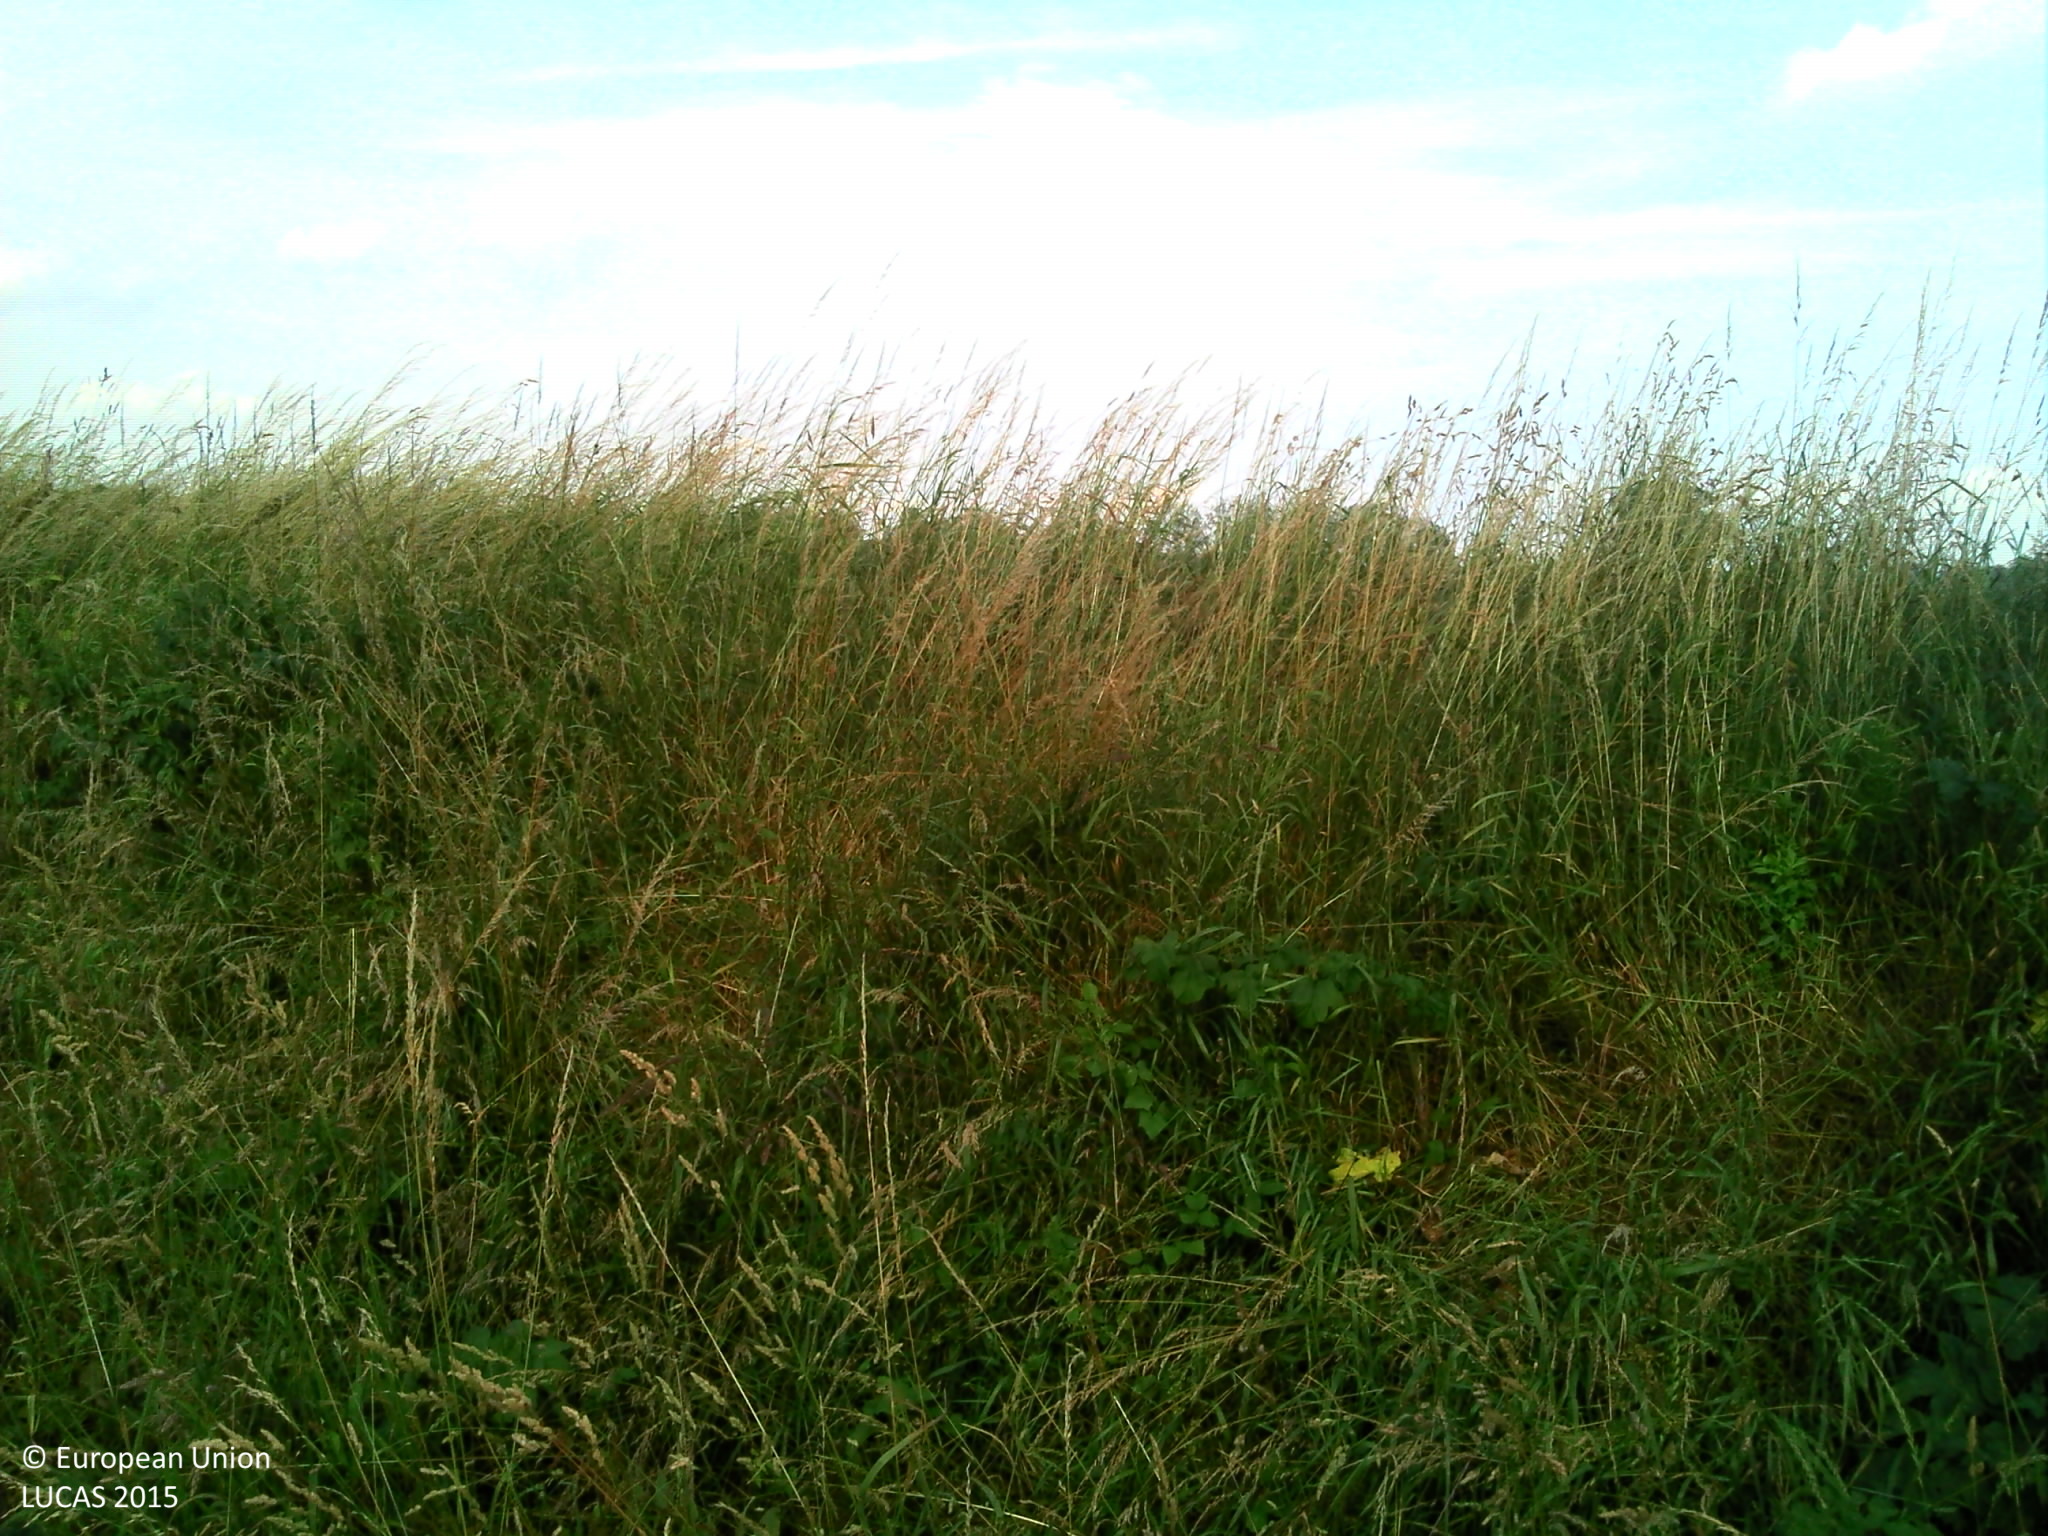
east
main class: Grassland
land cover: Grassland without tree/shrub cover
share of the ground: > 75 %
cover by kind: herbaceous plants 100 %
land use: Agriculture (excluding fallow land and kitchen gardens)
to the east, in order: Fences; Grass margins; Ditches and canals; Grassland without tree/shrub cover; Spontaneously vegetated surfaces
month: June
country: FR
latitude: 46.9553
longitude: 5.3895
